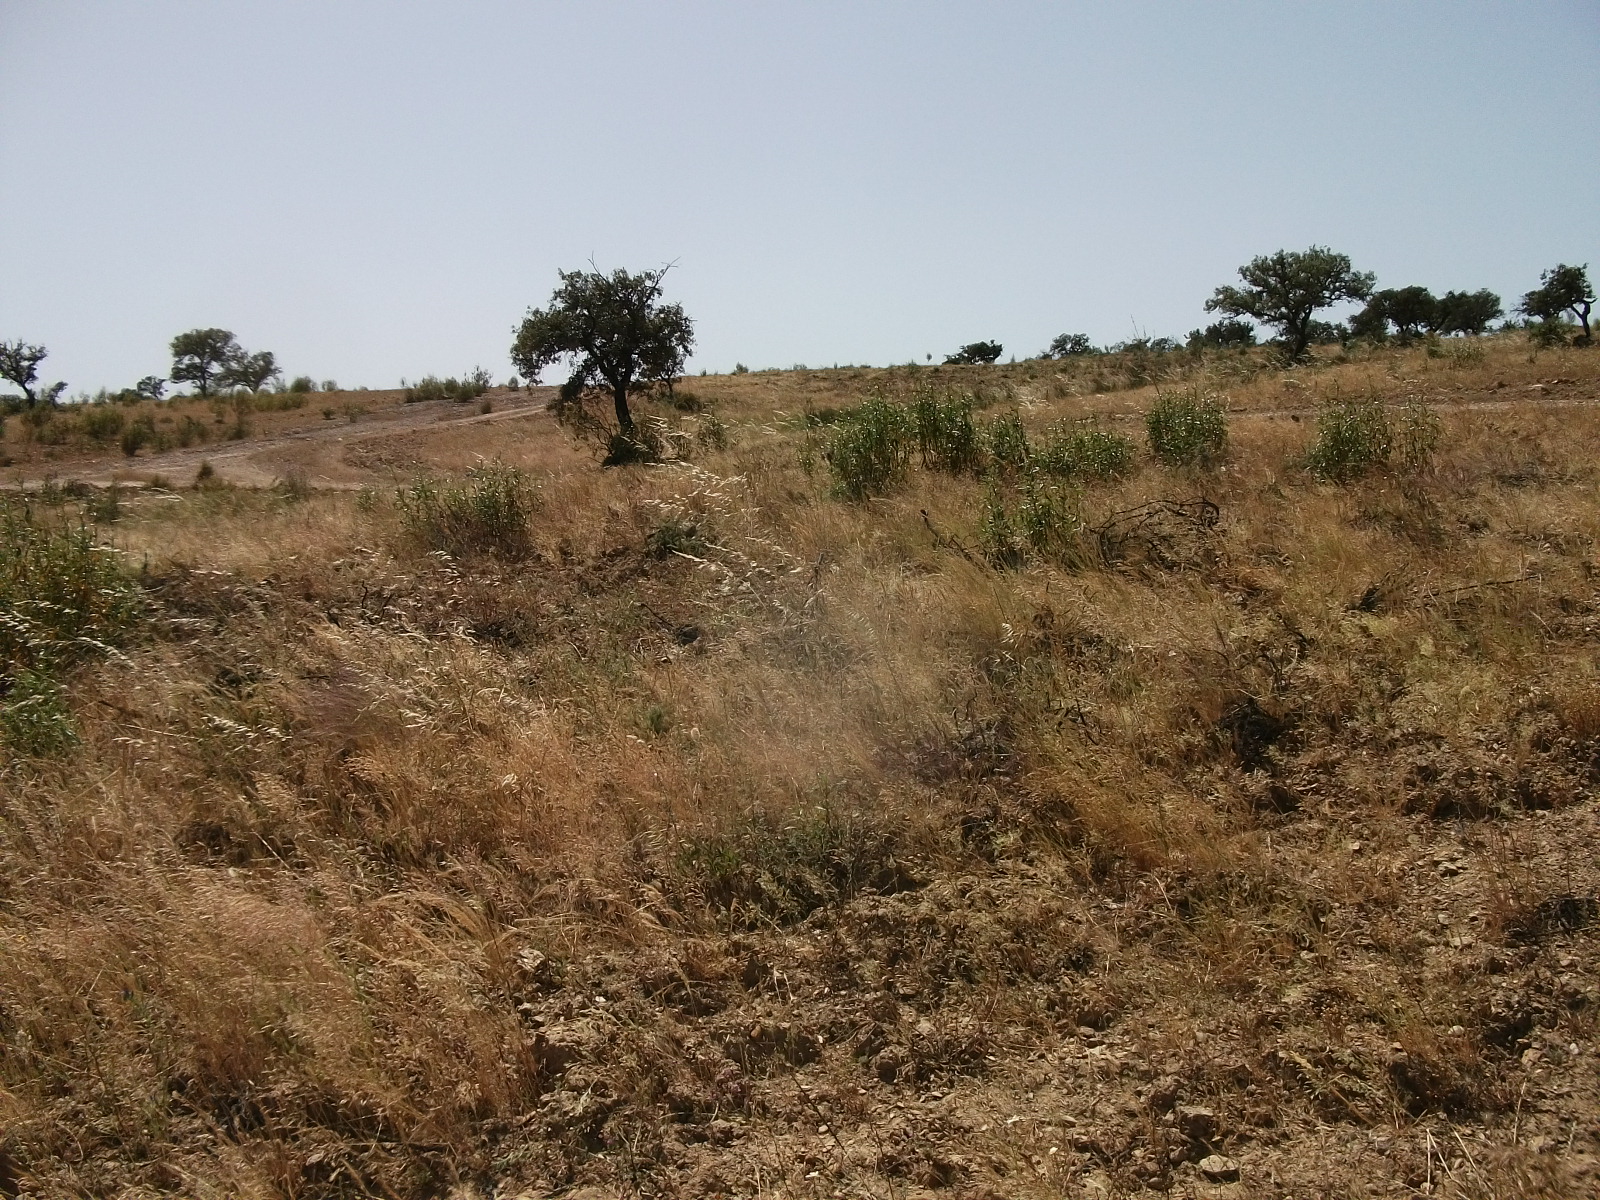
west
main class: Shrubland
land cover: Shrubland without tree cover
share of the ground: 50 - 75 %
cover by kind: herbaceous plants 55 %, shrubs 45 %
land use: Agriculture (excluding fallow land and kitchen gardens)
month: May
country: ES
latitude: 37.7331
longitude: -7.1285
